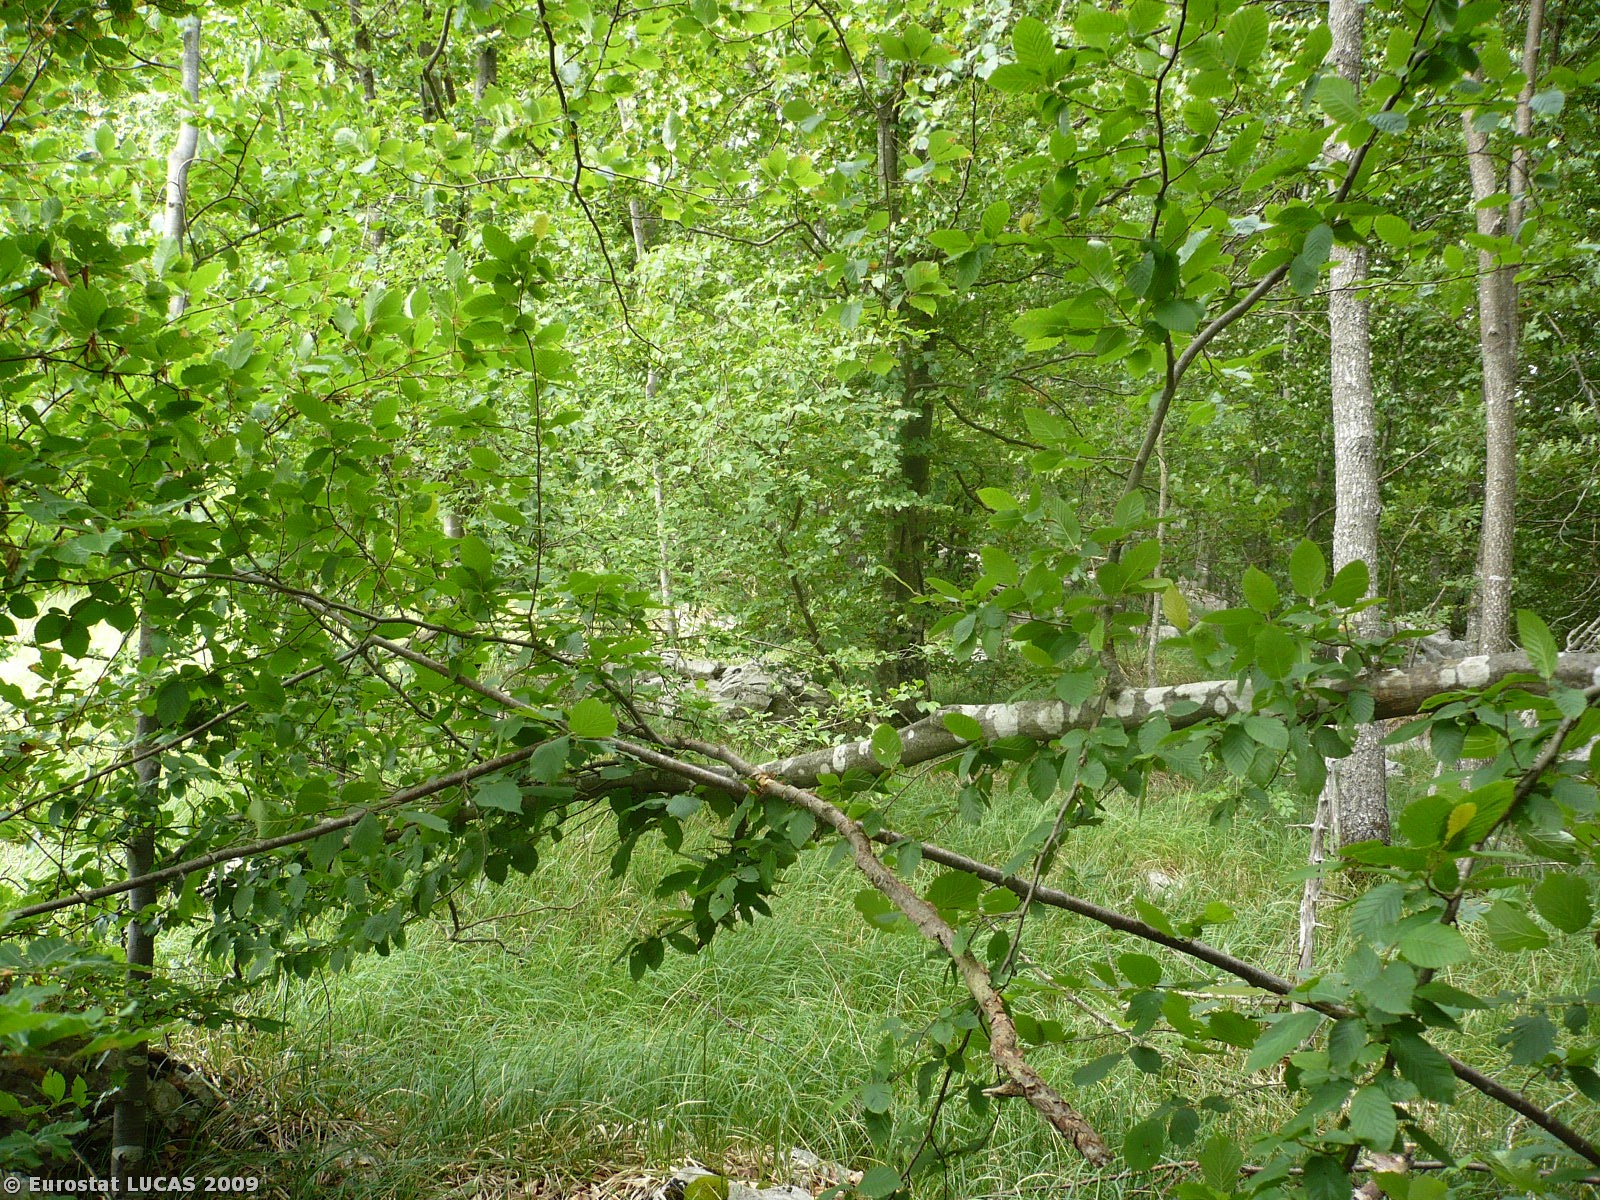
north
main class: Woodland
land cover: Broadleaved woodland
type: beech forest
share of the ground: > 75 %
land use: Forestry
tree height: > 5 m
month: June
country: SI
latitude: 45.4949
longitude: 14.1541
